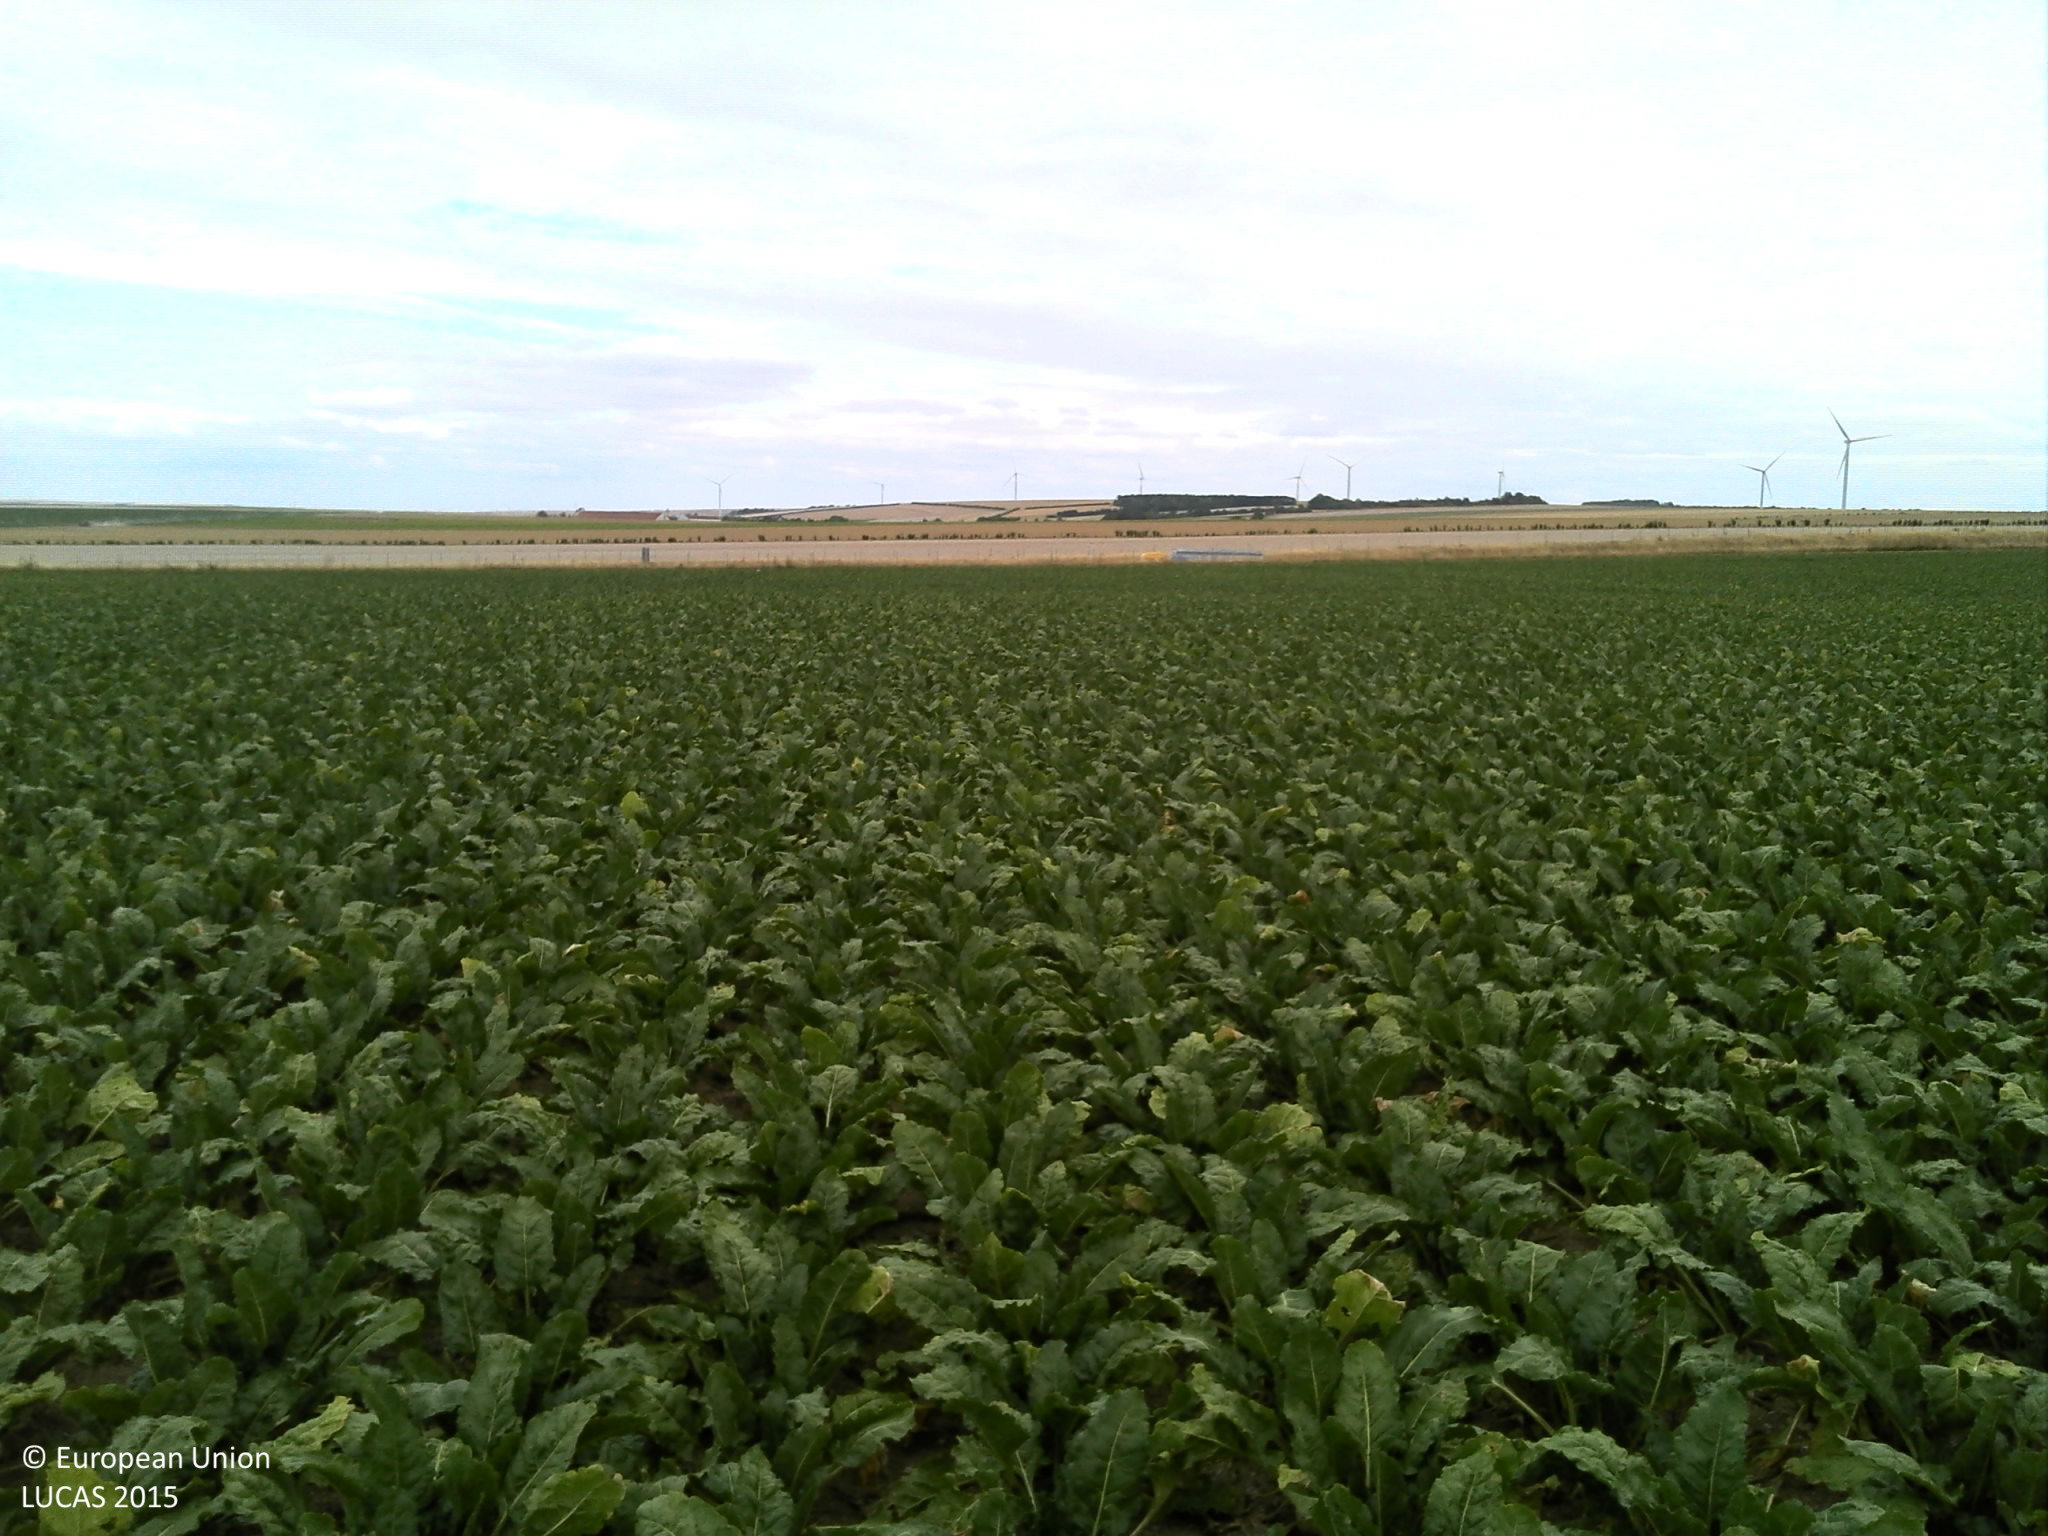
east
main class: Cropland
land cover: Sugar beet
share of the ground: > 75 %
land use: Agriculture (excluding fallow land and kitchen gardens)
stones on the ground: < 10 %
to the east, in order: Sugar beet; Grass margins; Tracks; Grass margins; Fences; Grassland without tree/shrub cover; Ditches and canals; Paved roads, cycling and walking lanes; Ditches and canals; Grassland without tree/shrub cover; Fences; Grass margins; Tracks; Grass margins; Rape and turnip rape
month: August
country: FR
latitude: 48.5019
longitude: 4.1630
